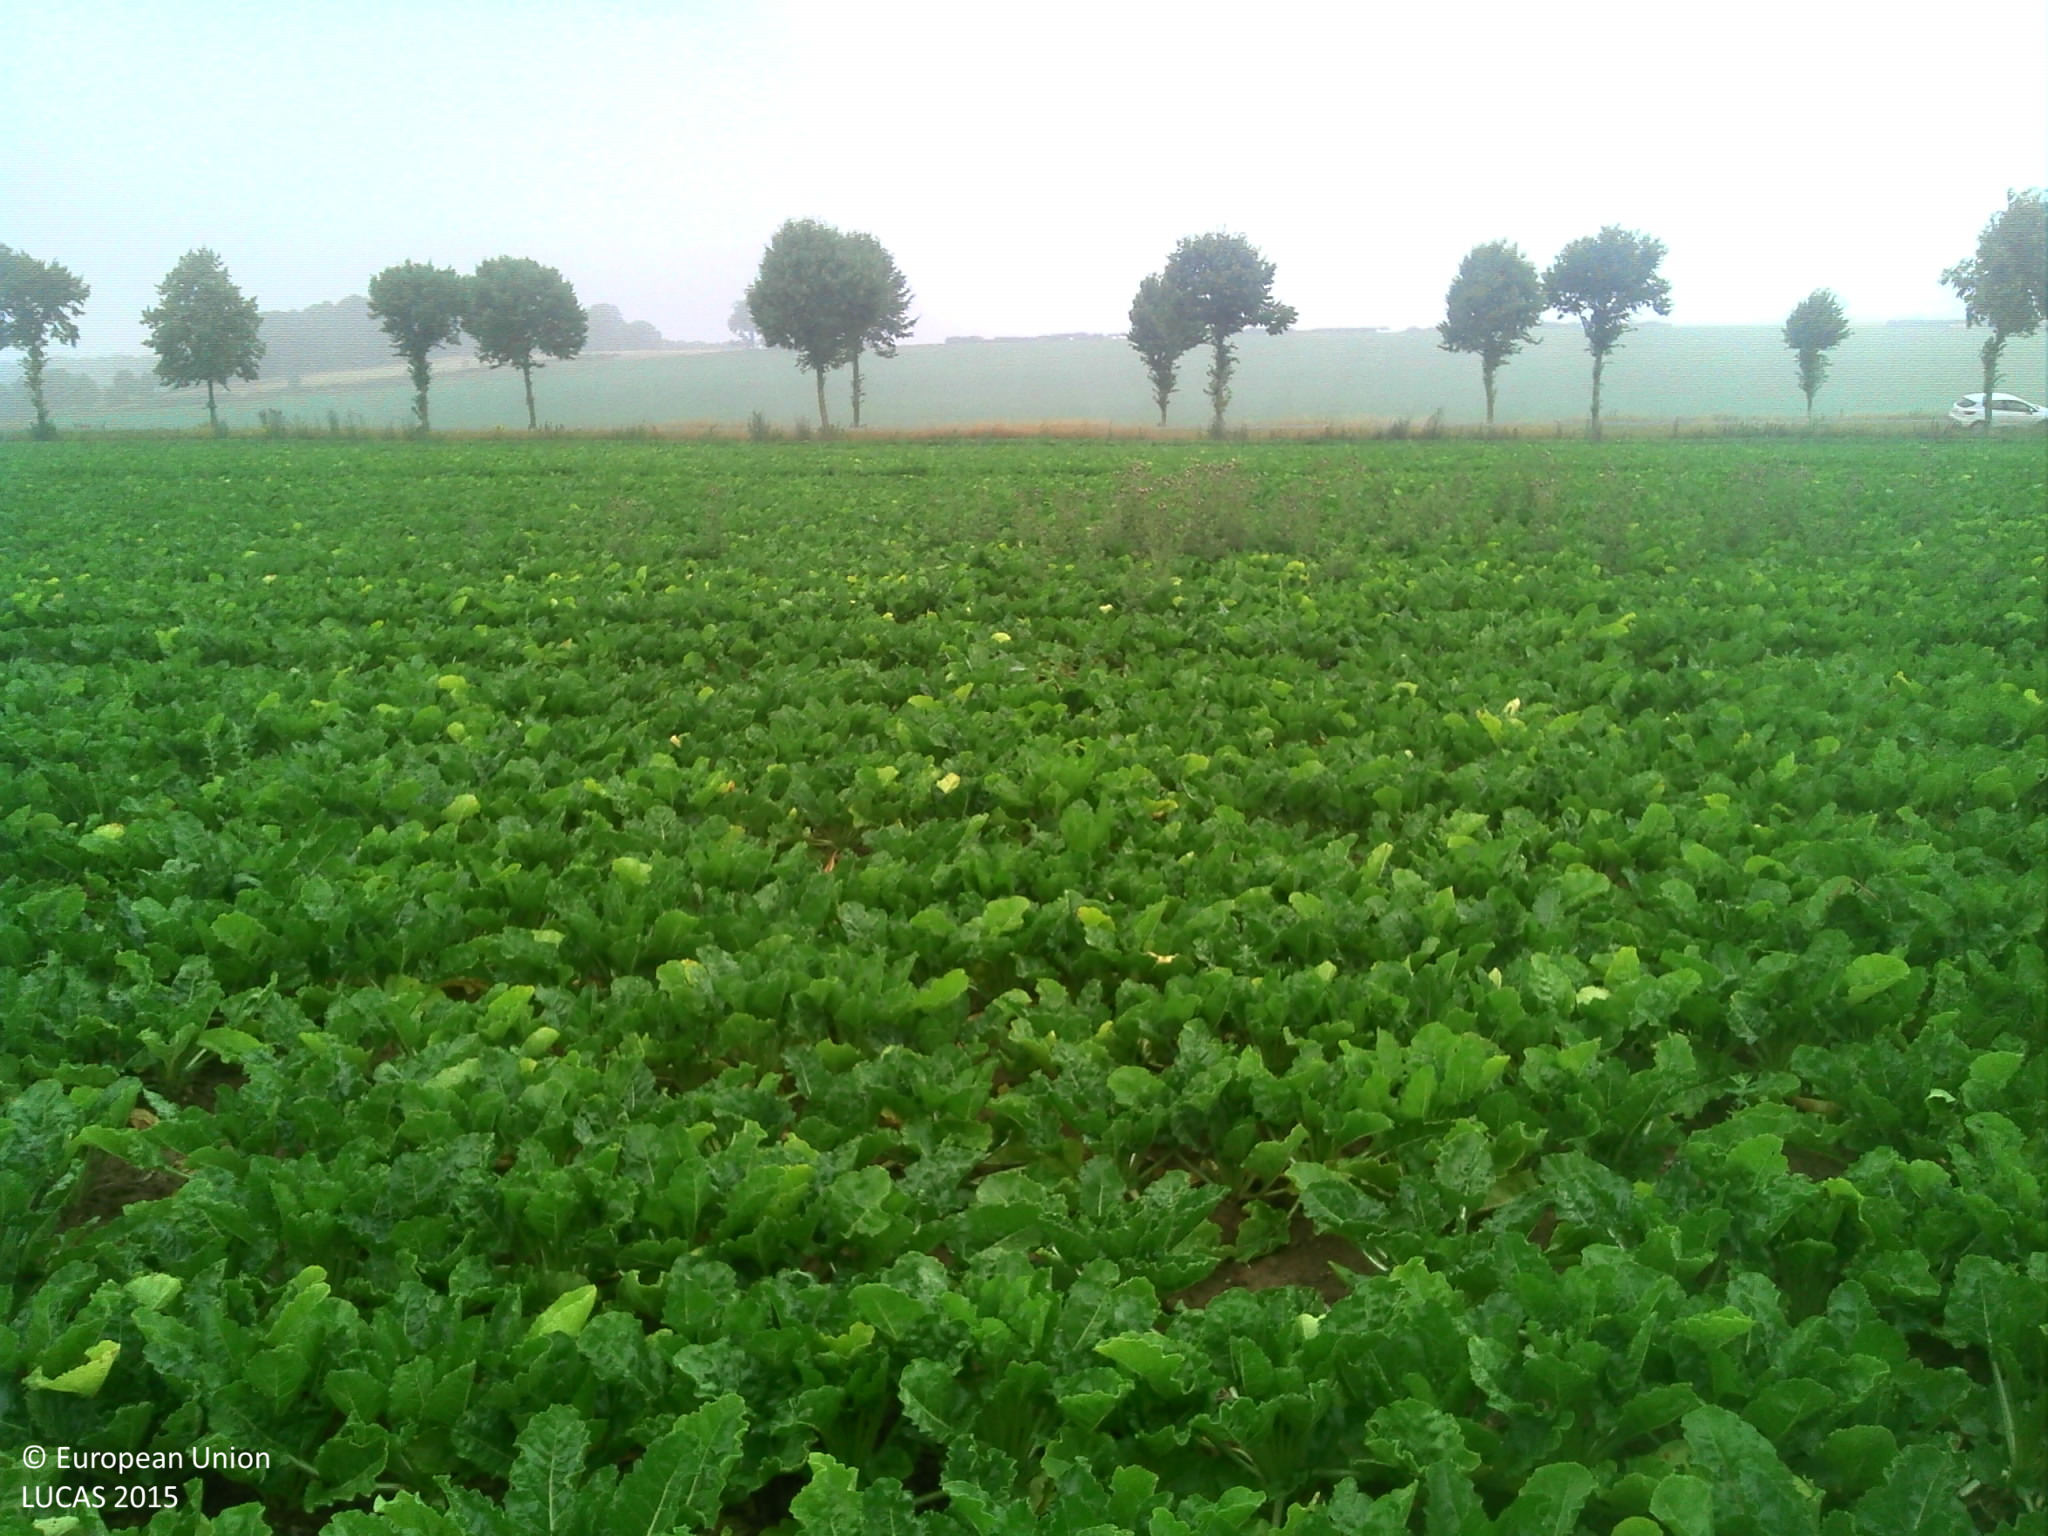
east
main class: Cropland
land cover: Sugar beet
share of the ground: > 75 %
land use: Agriculture (excluding fallow land and kitchen gardens)
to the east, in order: Sugar beet; Common wheat
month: July
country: FR
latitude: 49.9158
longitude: 3.6285
